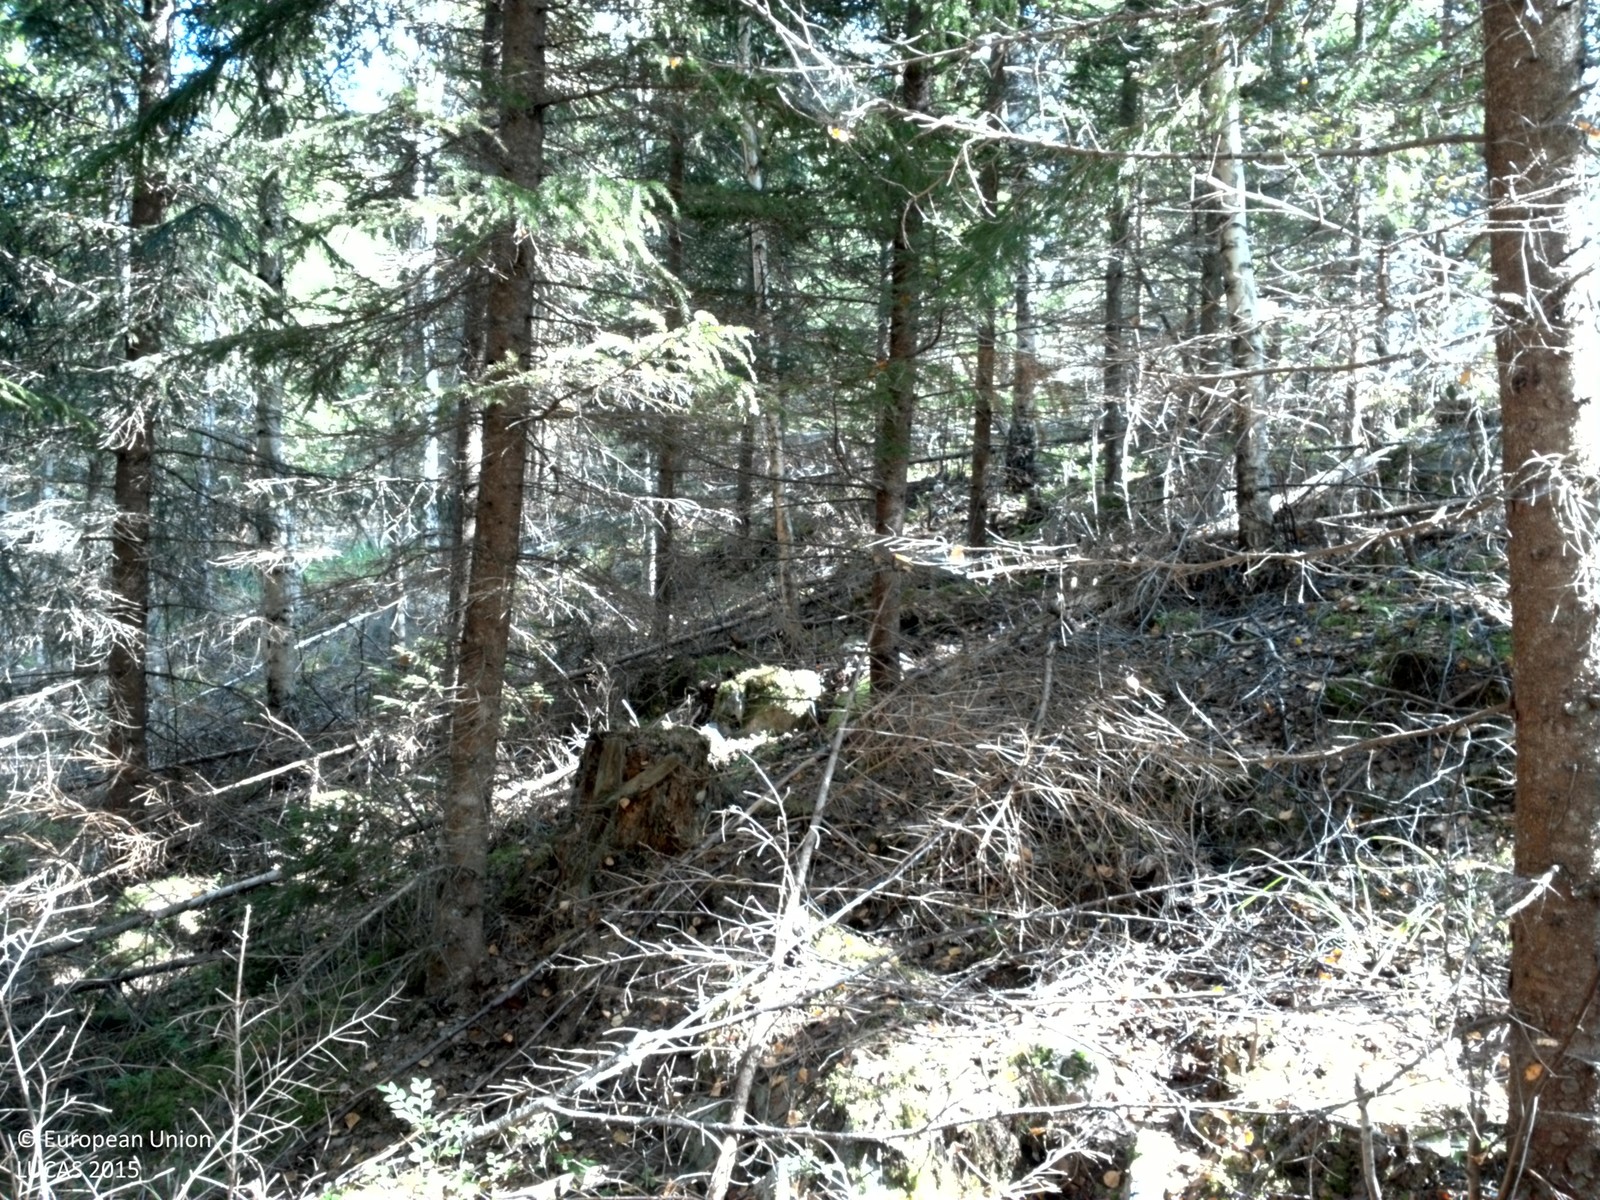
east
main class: Woodland
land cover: Spruce dominated coniferous woodland
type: boreal forest
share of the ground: > 75 %
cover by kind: coniferous forest trees 80 %, broadleaved forest trees 10 %, lichens and mosses 5 %, unconsolidated bare surface 5 %
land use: Forestry
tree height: > 5 m
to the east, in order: Spruce dominated coniferous woodland; Spruce dominated mixed woodland; Spruce dominated coniferous woodland; Spruce dominated mixed woodland
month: August
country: SE
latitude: 60.0727
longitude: 17.8108
